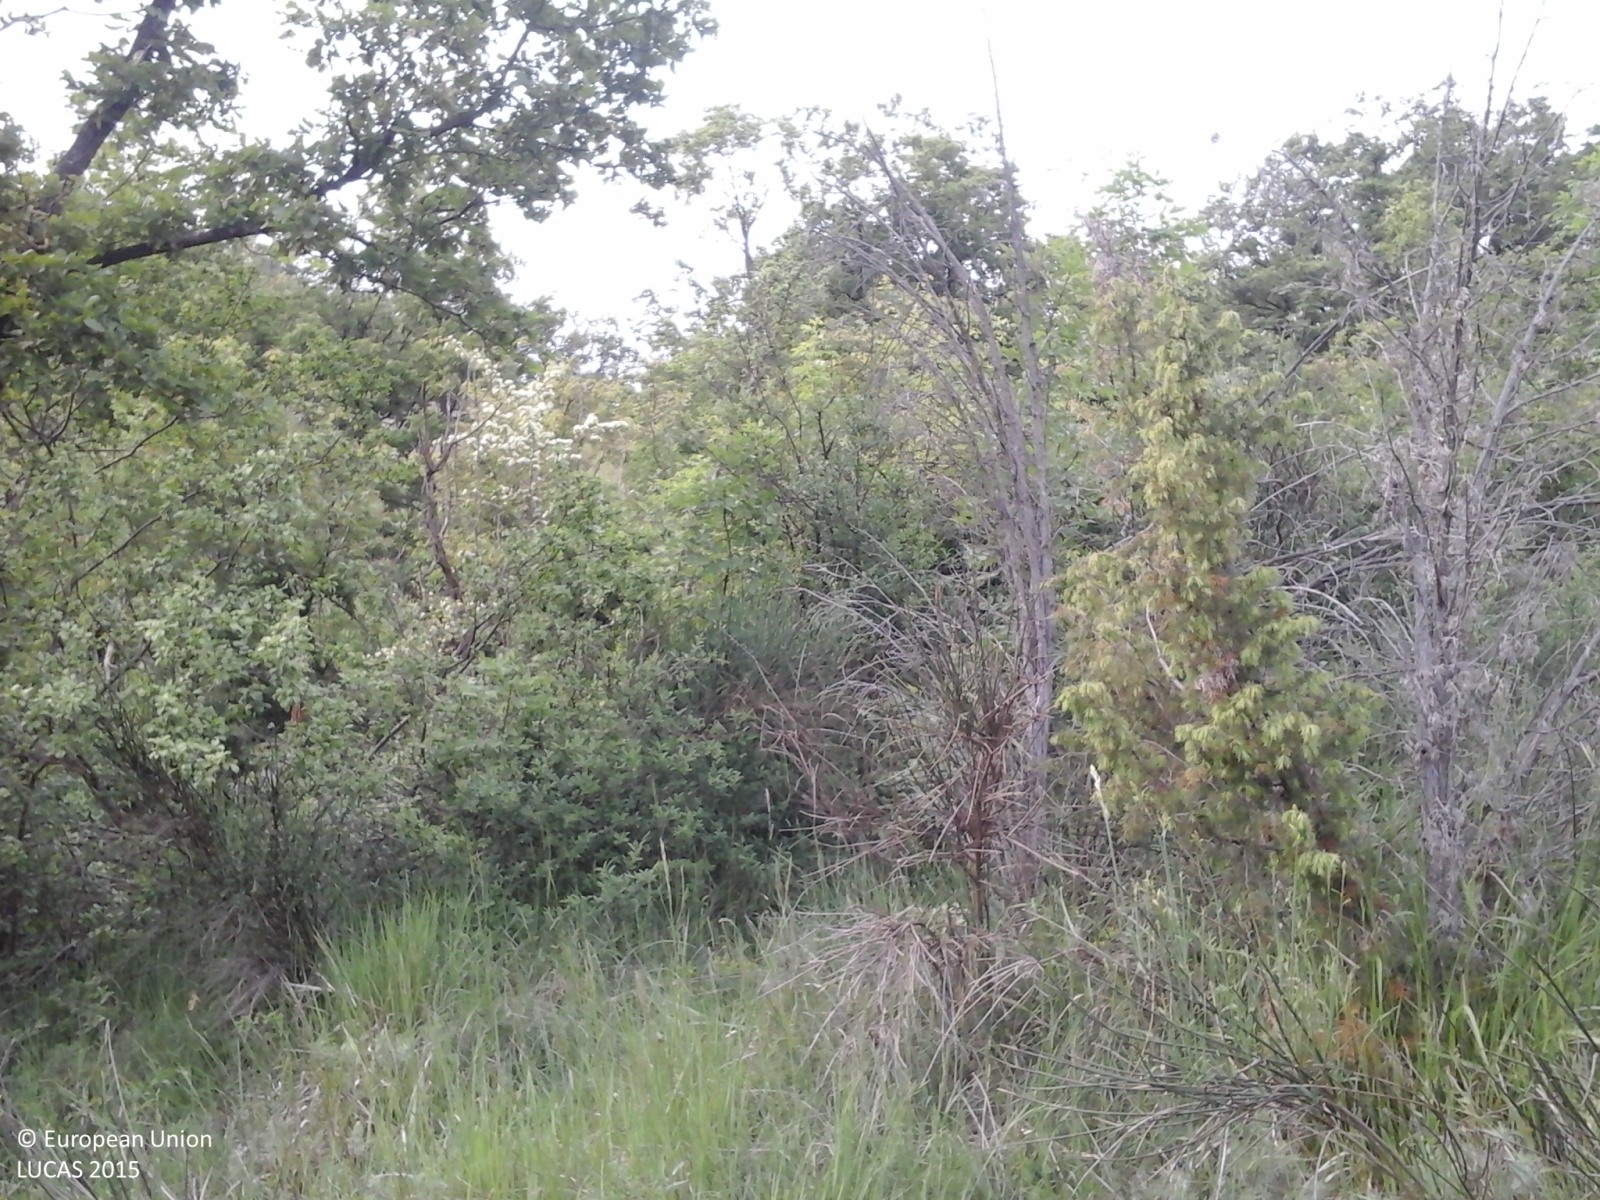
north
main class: Woodland
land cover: Broadleaved woodland
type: mesophytic deciduous forest
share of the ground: 50 - 75 %
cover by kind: broadleaved forest trees 65 %, herbaceous plants 20 %, shrubs 10 %, unconsolidated bare surface 5 %
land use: Semi-natural and natural areas not in use
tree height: > 5 m
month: May
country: IT
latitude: 44.4189
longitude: 10.8897
